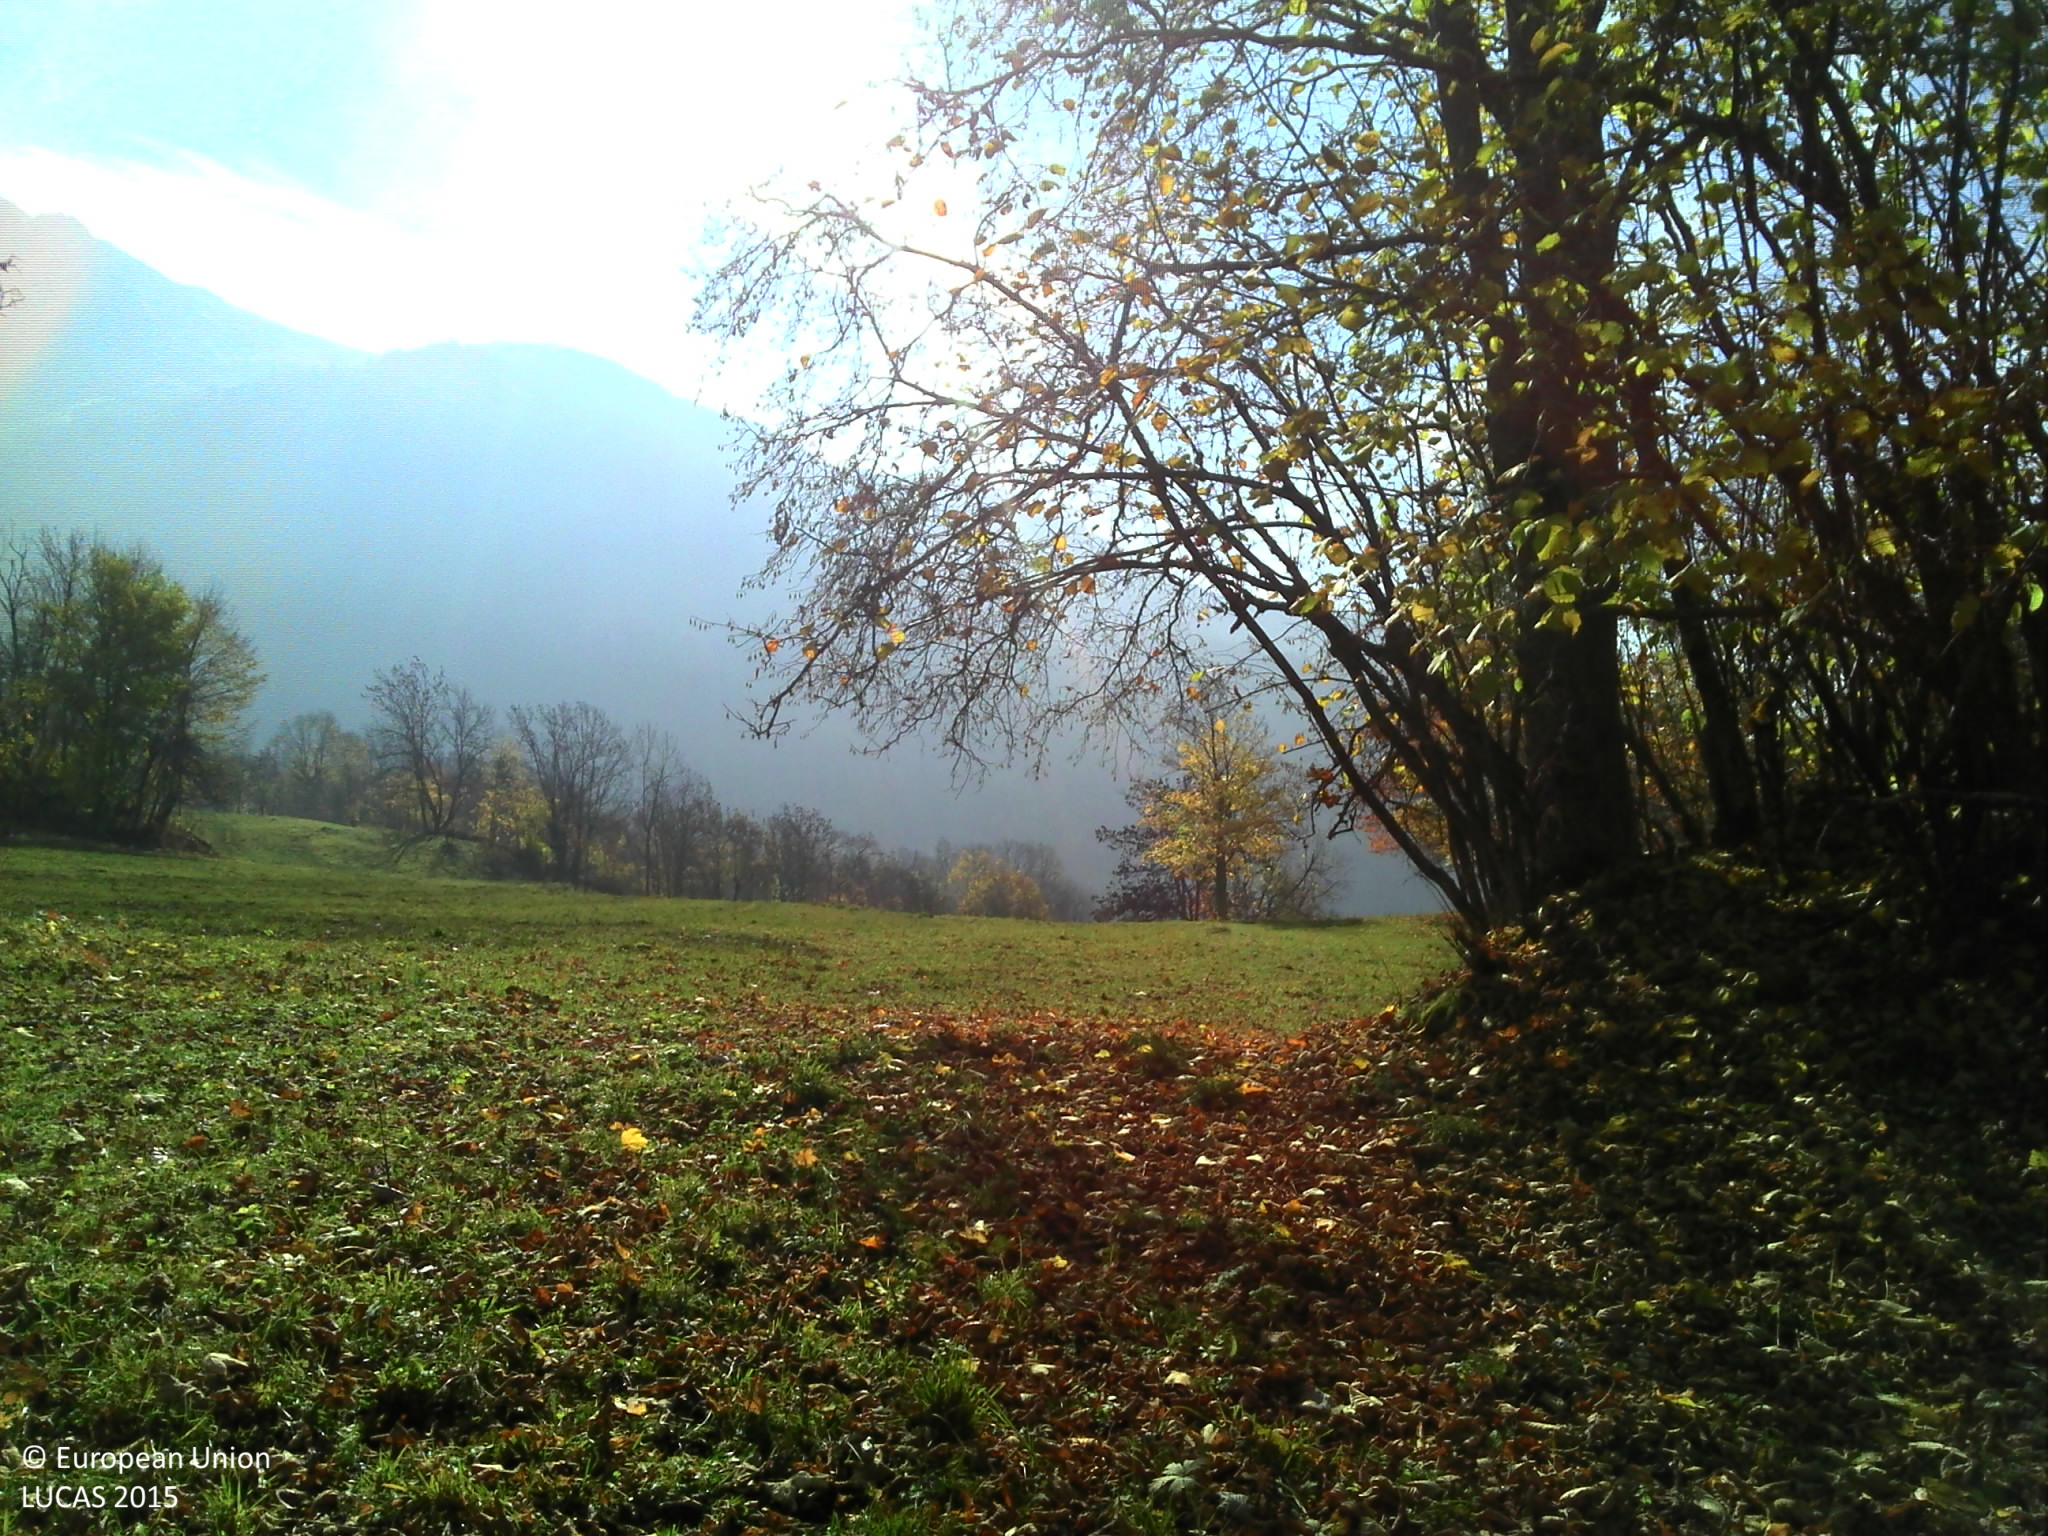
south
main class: Woodland
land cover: Broadleaved woodland
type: mesophytic deciduous forest
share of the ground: 25 - 50 %
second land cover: Grassland without tree/shrub cover
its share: > 75 %
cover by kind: herbaceous plants 70 %, broadleaved forest trees 30 %
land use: Forestry
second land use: Agriculture (excluding fallow land and kitchen gardens)
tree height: > 5 m
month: October
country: FR
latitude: 45.3697
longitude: 6.3659
